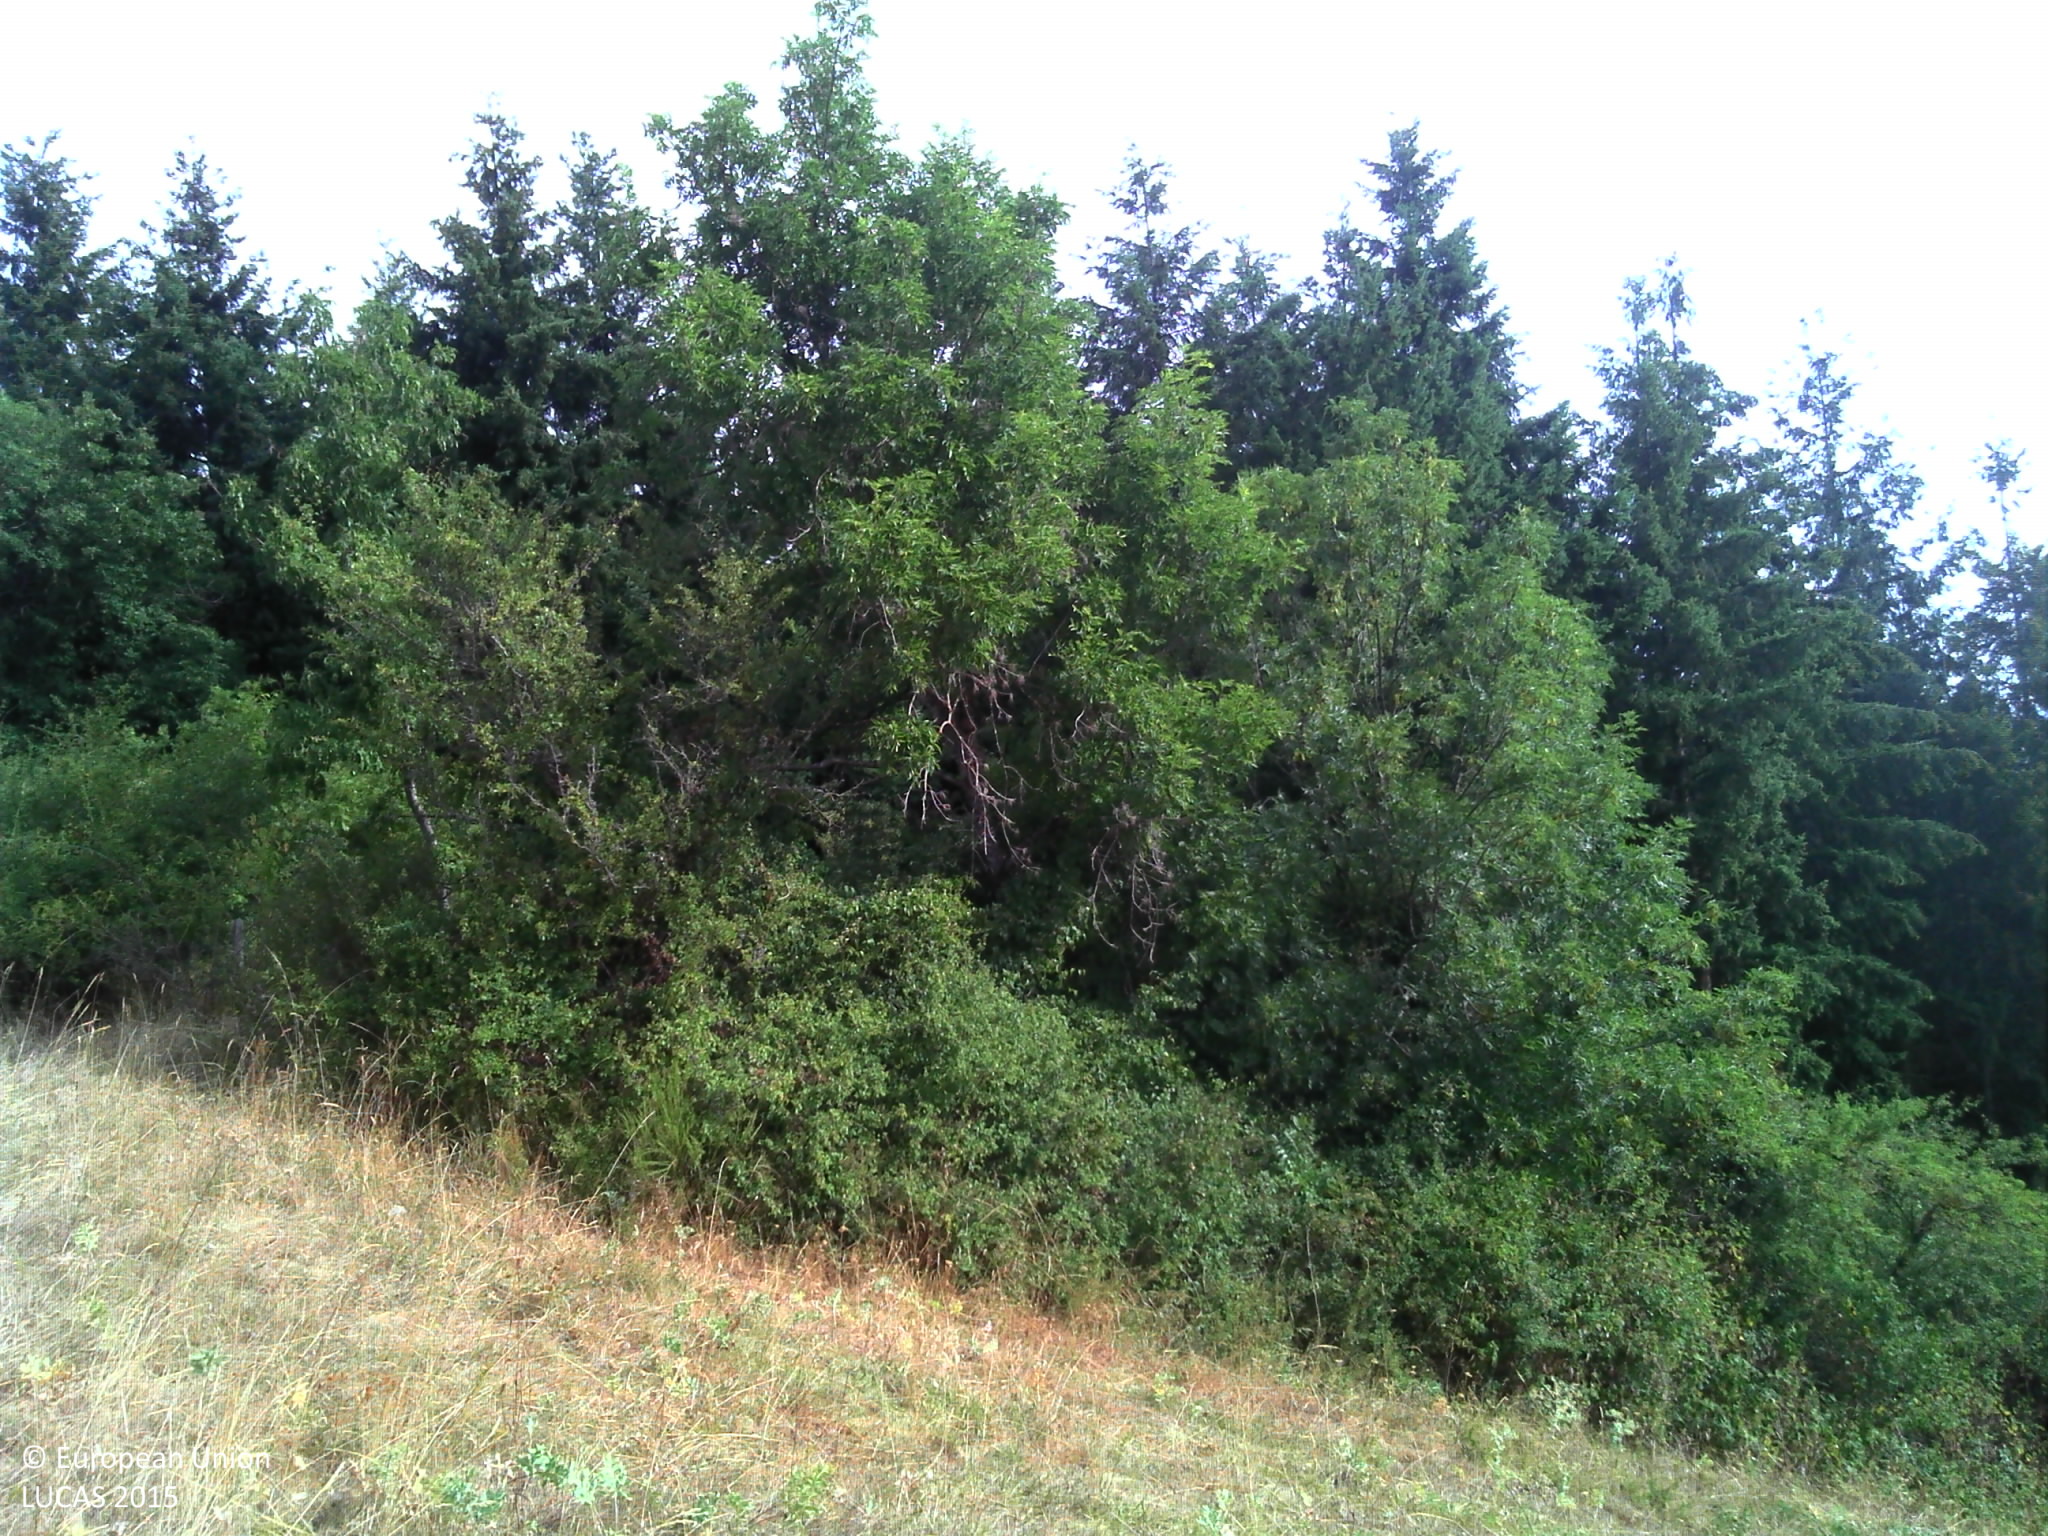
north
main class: Grassland
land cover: Grassland without tree/shrub cover
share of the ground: > 75 %
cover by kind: herbaceous plants 100 %
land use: Agriculture (excluding fallow land and kitchen gardens)
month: July
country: FR
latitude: 45.9014
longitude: 4.4731
